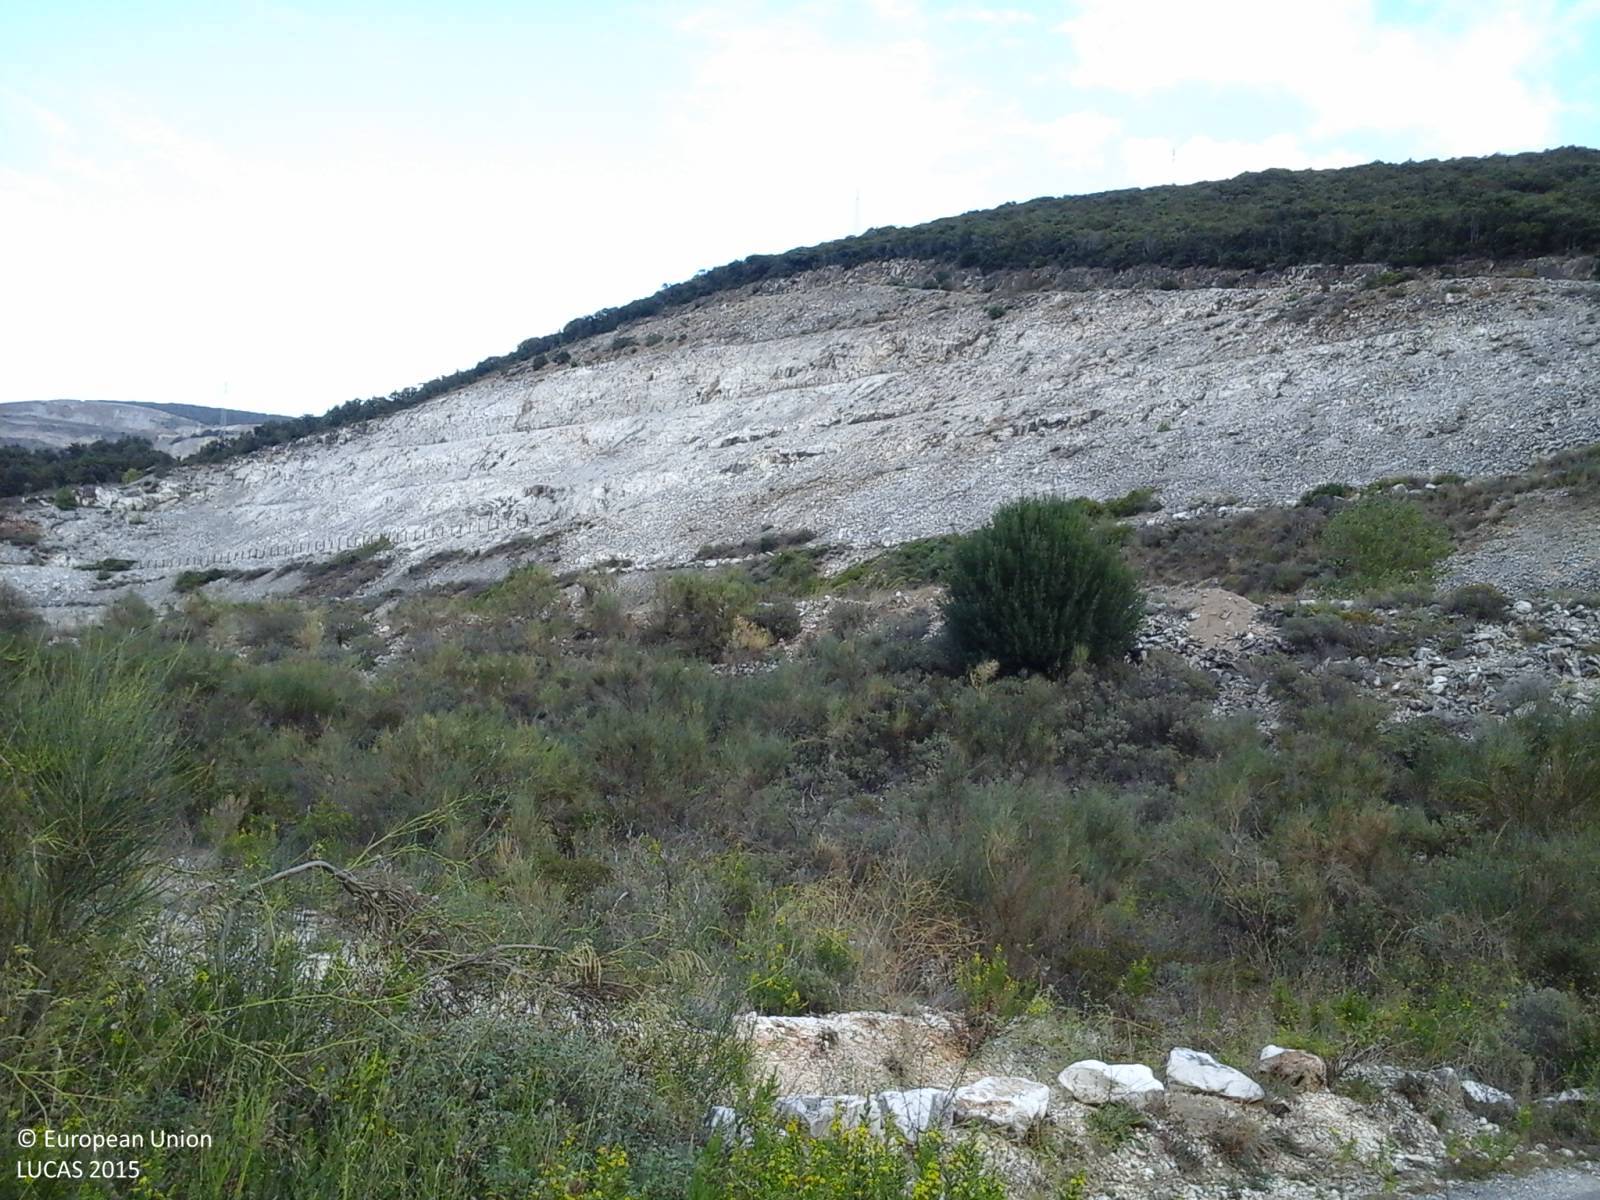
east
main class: Woodland
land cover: Broadleaved woodland
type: thermophilous deciduous forest
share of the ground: > 75 %
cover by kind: broadleaved forest trees 100 %
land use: Forestry
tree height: > 5 m
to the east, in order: Broadleaved woodland; Shrubland with sparse tree cover
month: September
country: IT
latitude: 43.0856
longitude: 10.6000
